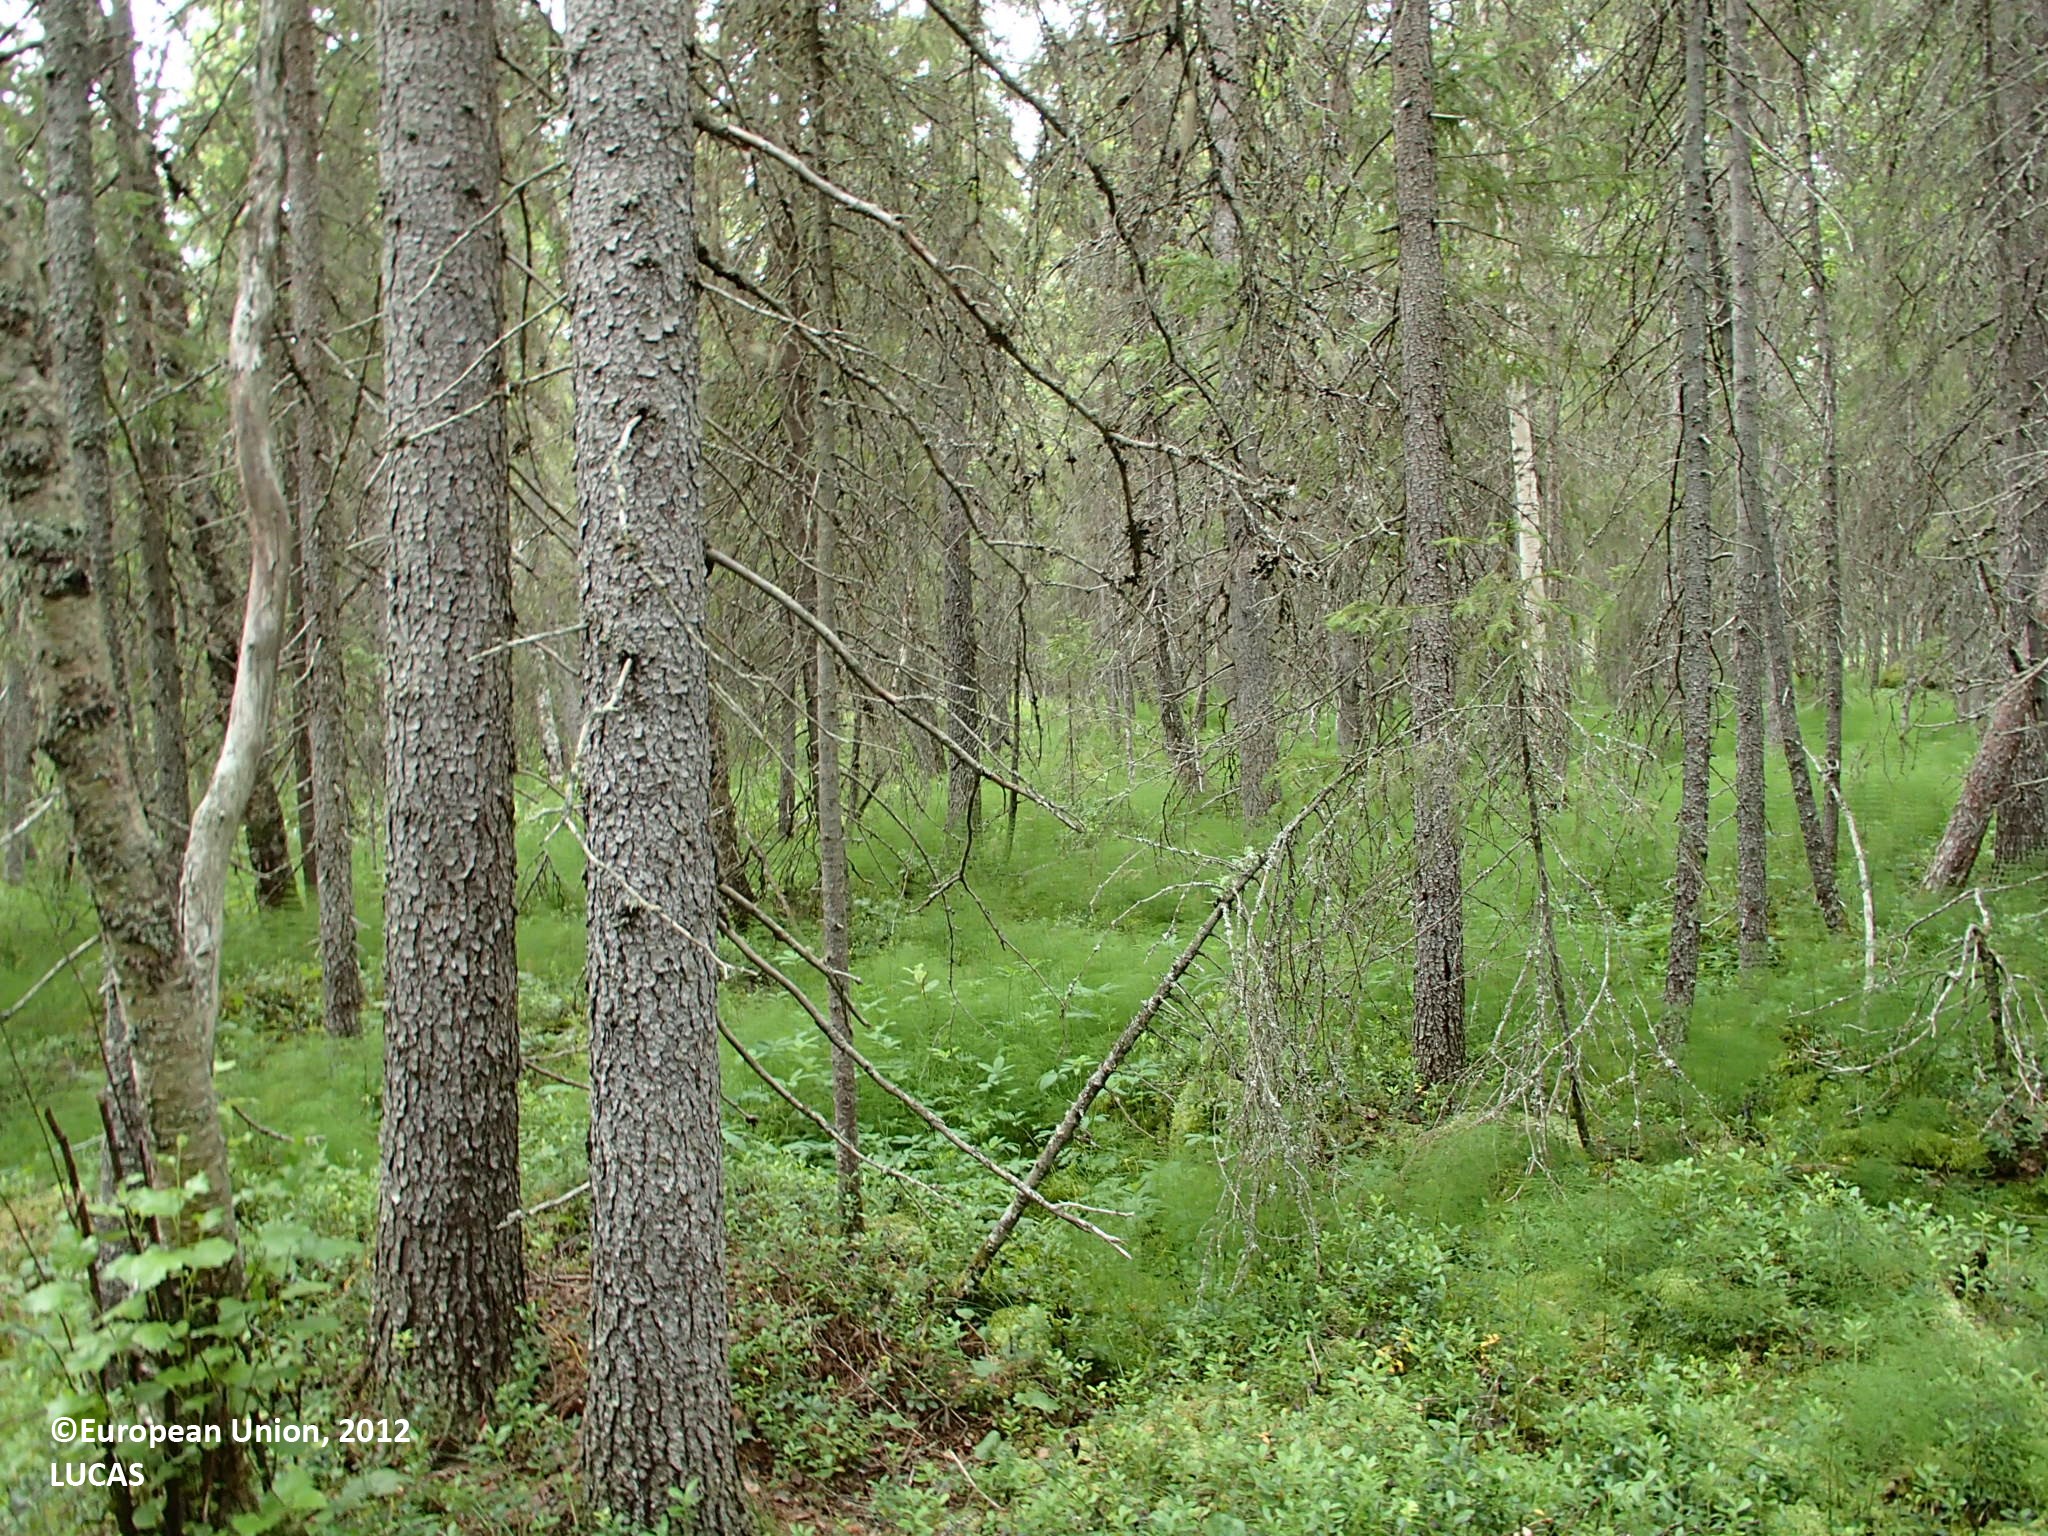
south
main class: Woodland
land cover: Other coniferous woodland
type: boreal forest
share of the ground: > 75 %
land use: Forestry
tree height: > 5 m
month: July
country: FI
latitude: 66.4151
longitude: 25.4056
